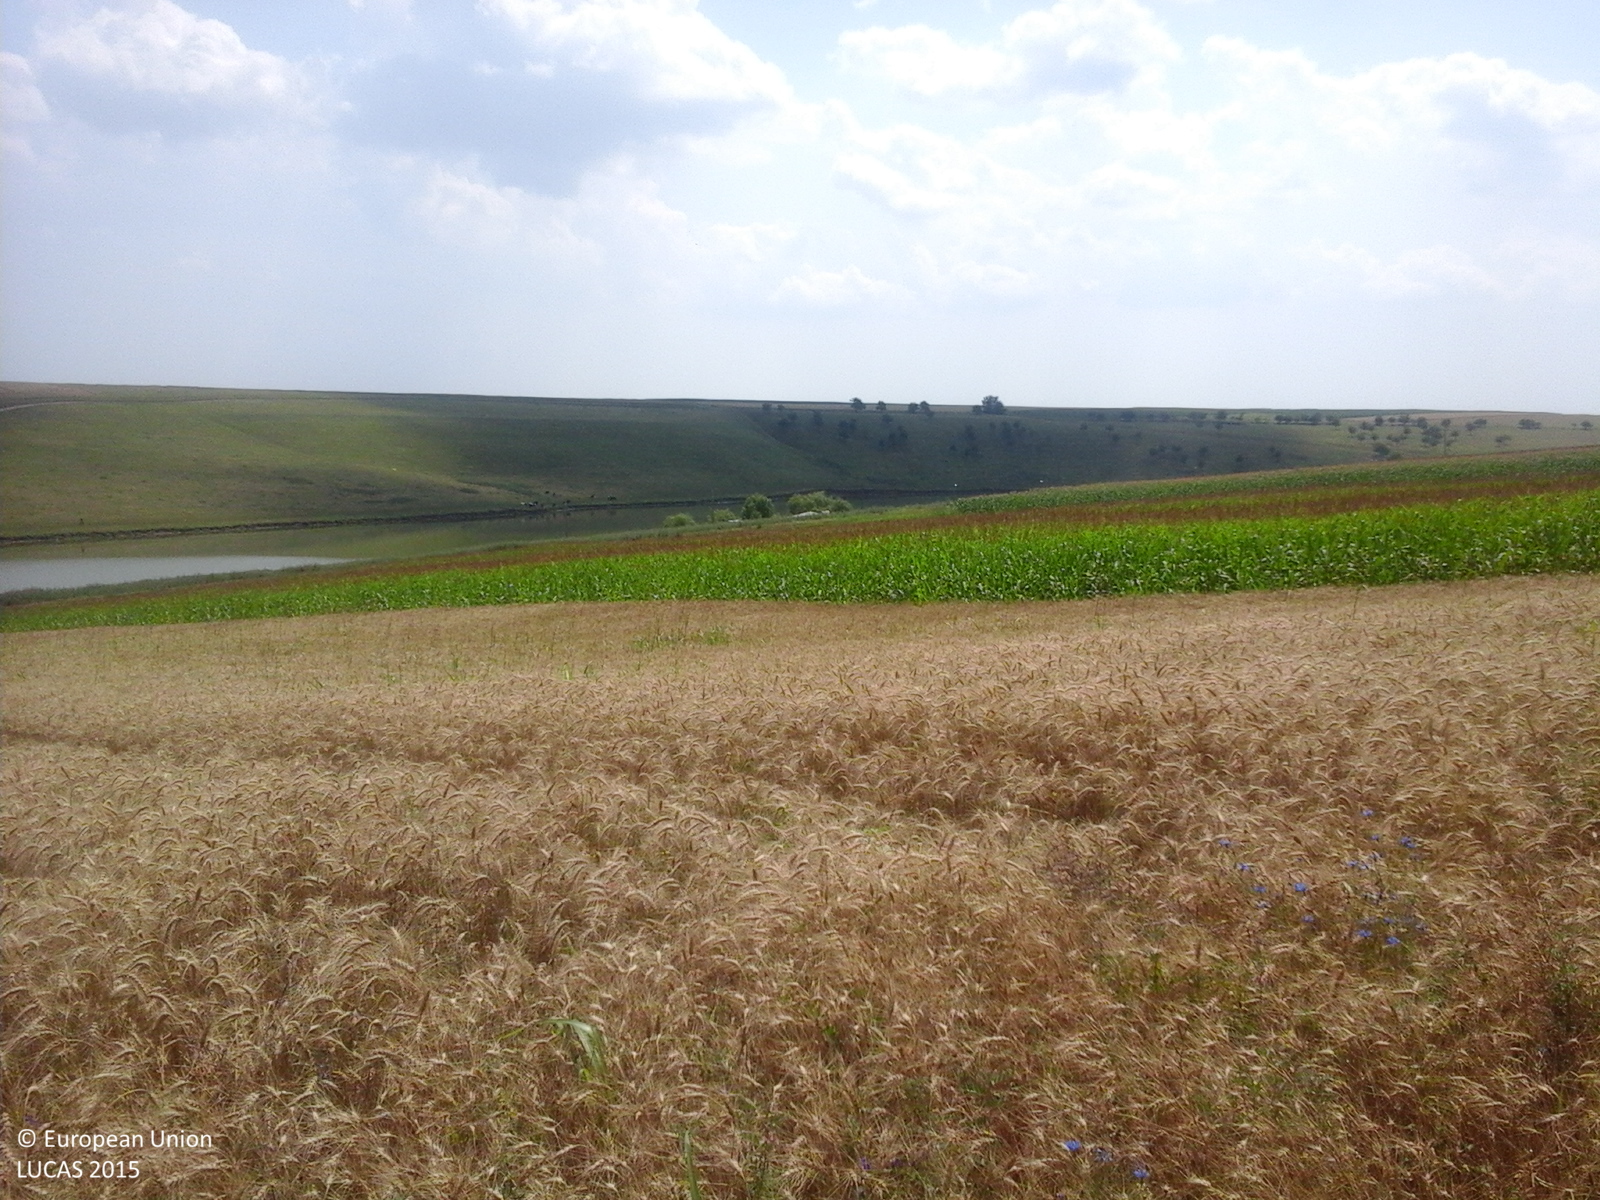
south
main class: Cropland
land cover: Sunflower
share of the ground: > 75 %
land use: Agriculture (excluding fallow land and kitchen gardens)
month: July
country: RO
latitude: 43.8576
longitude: 25.7289
